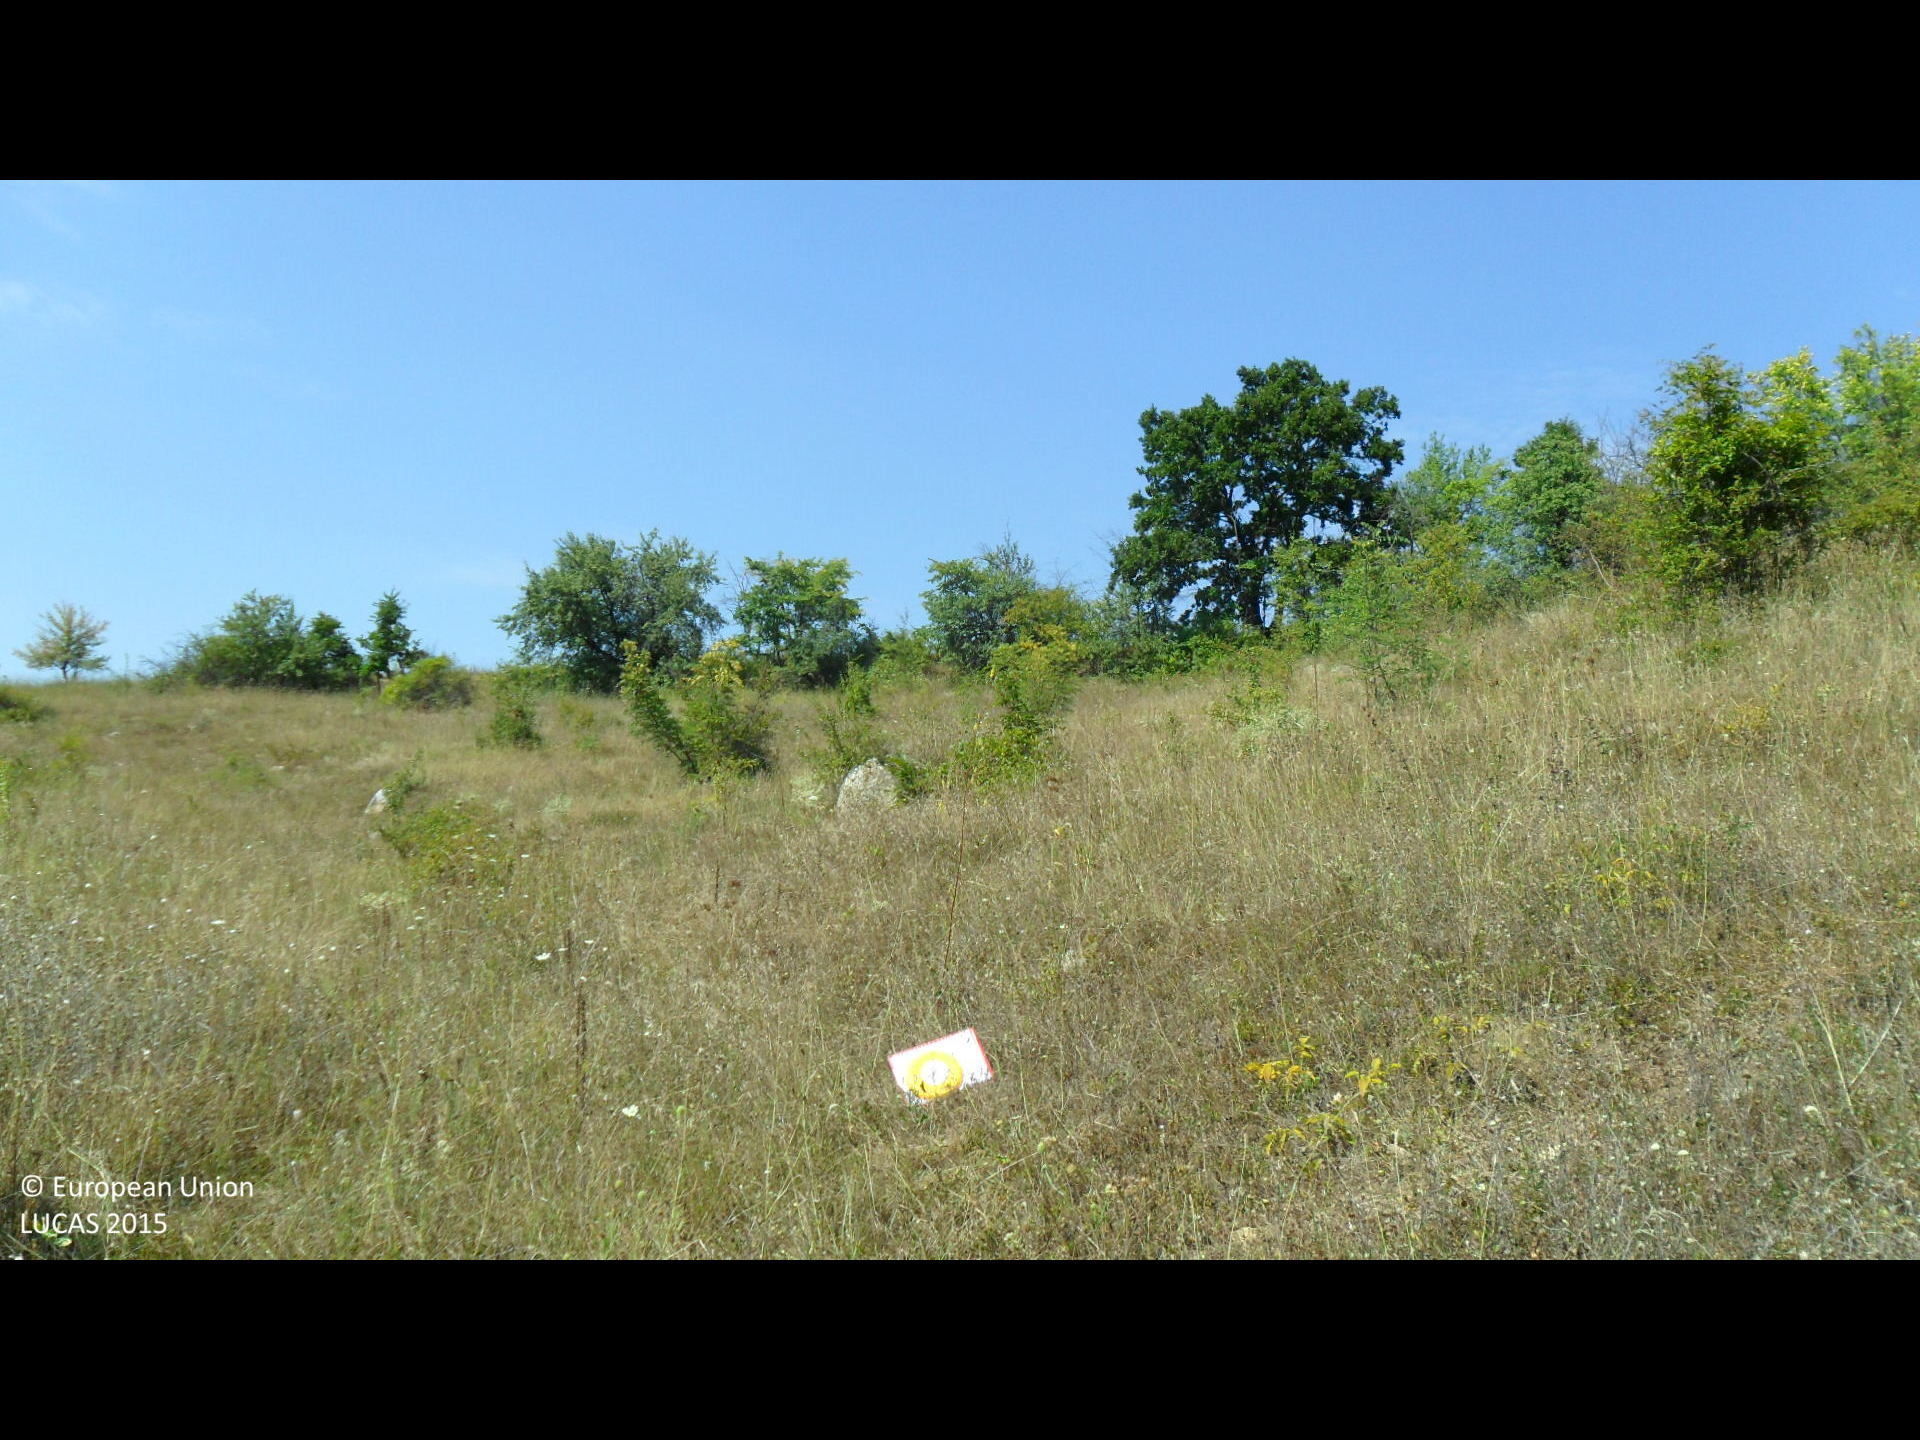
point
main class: Grassland
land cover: Grassland with sparse tree/shrub cover
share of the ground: > 75 %
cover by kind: herbaceous plants 90 %, broadleaved forest trees 5 %, shrubs 5 %
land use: Agriculture (excluding fallow land and kitchen gardens)
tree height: < 5 m
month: August
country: BG
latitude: 43.4785
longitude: 26.1557
